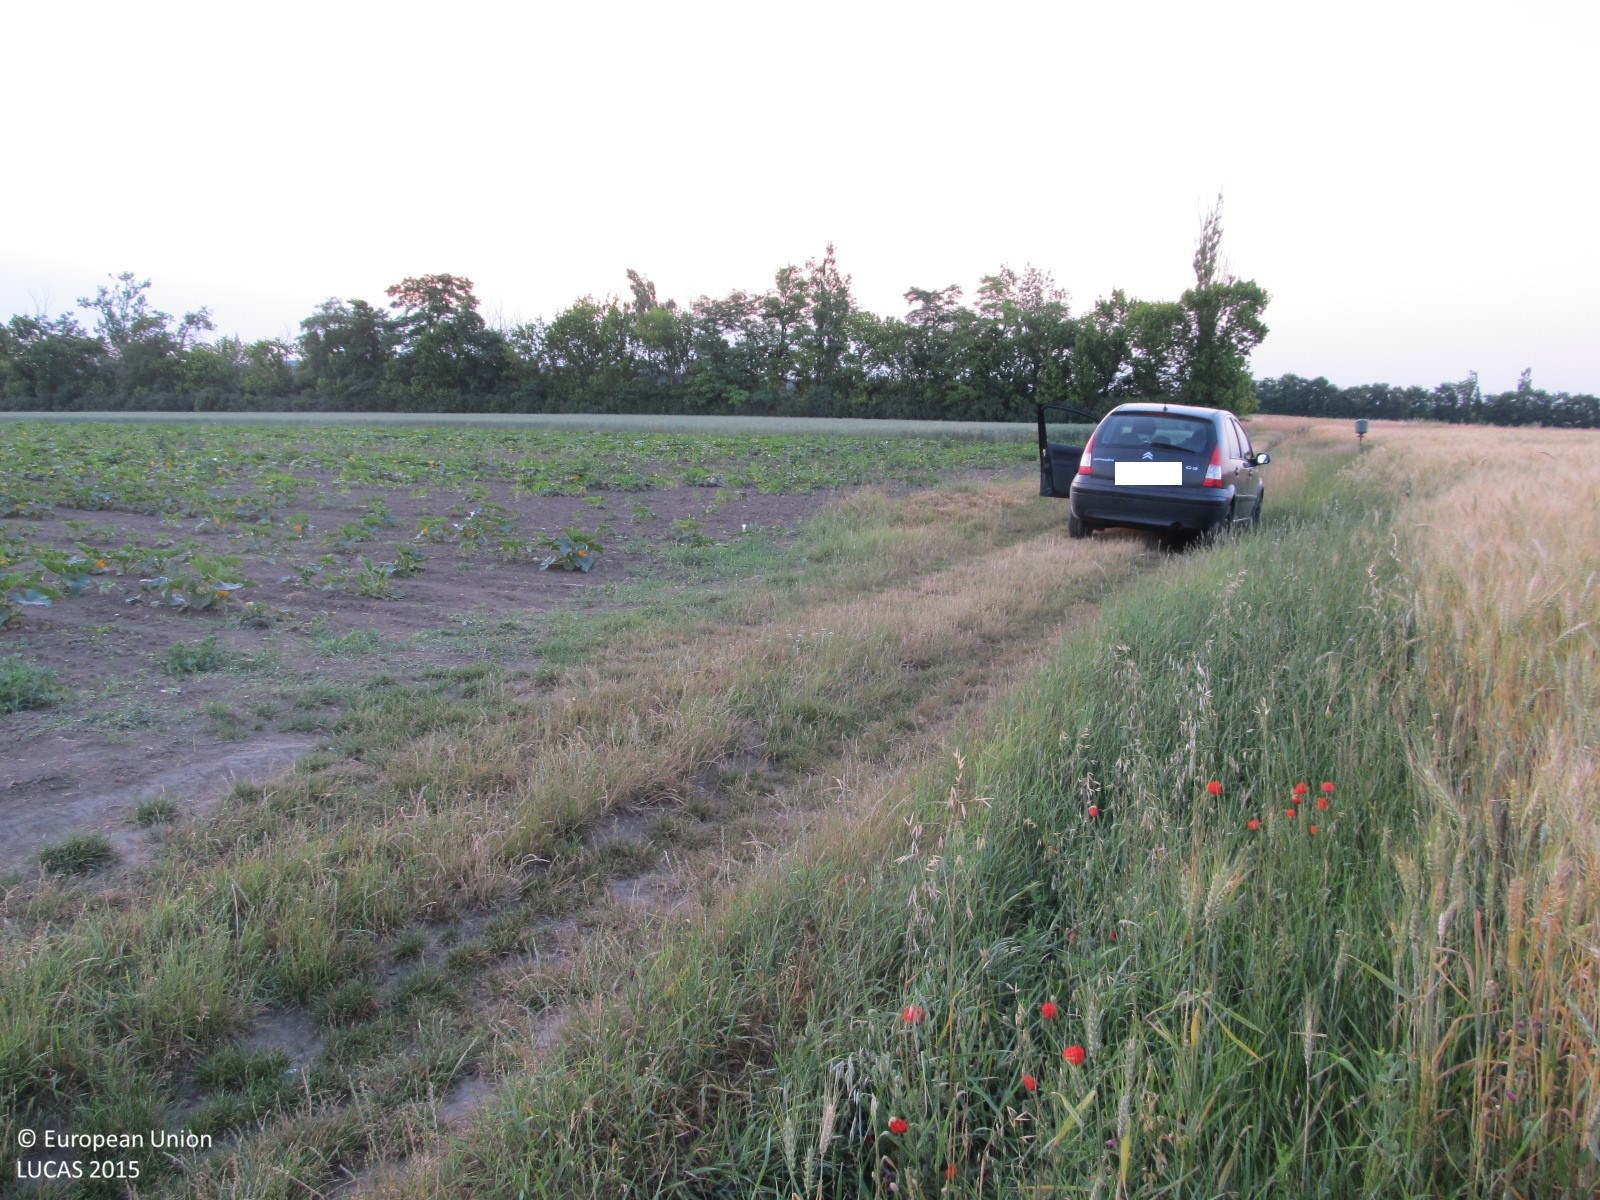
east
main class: Cropland
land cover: Common wheat
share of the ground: > 75 %
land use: Agriculture (excluding fallow land and kitchen gardens)
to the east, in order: Common wheat; Grass margins; Tracks; Grass margins; Triticale; Broadleaved woodland; Common wheat
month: July
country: AT
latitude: 48.7156
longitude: 15.8893
